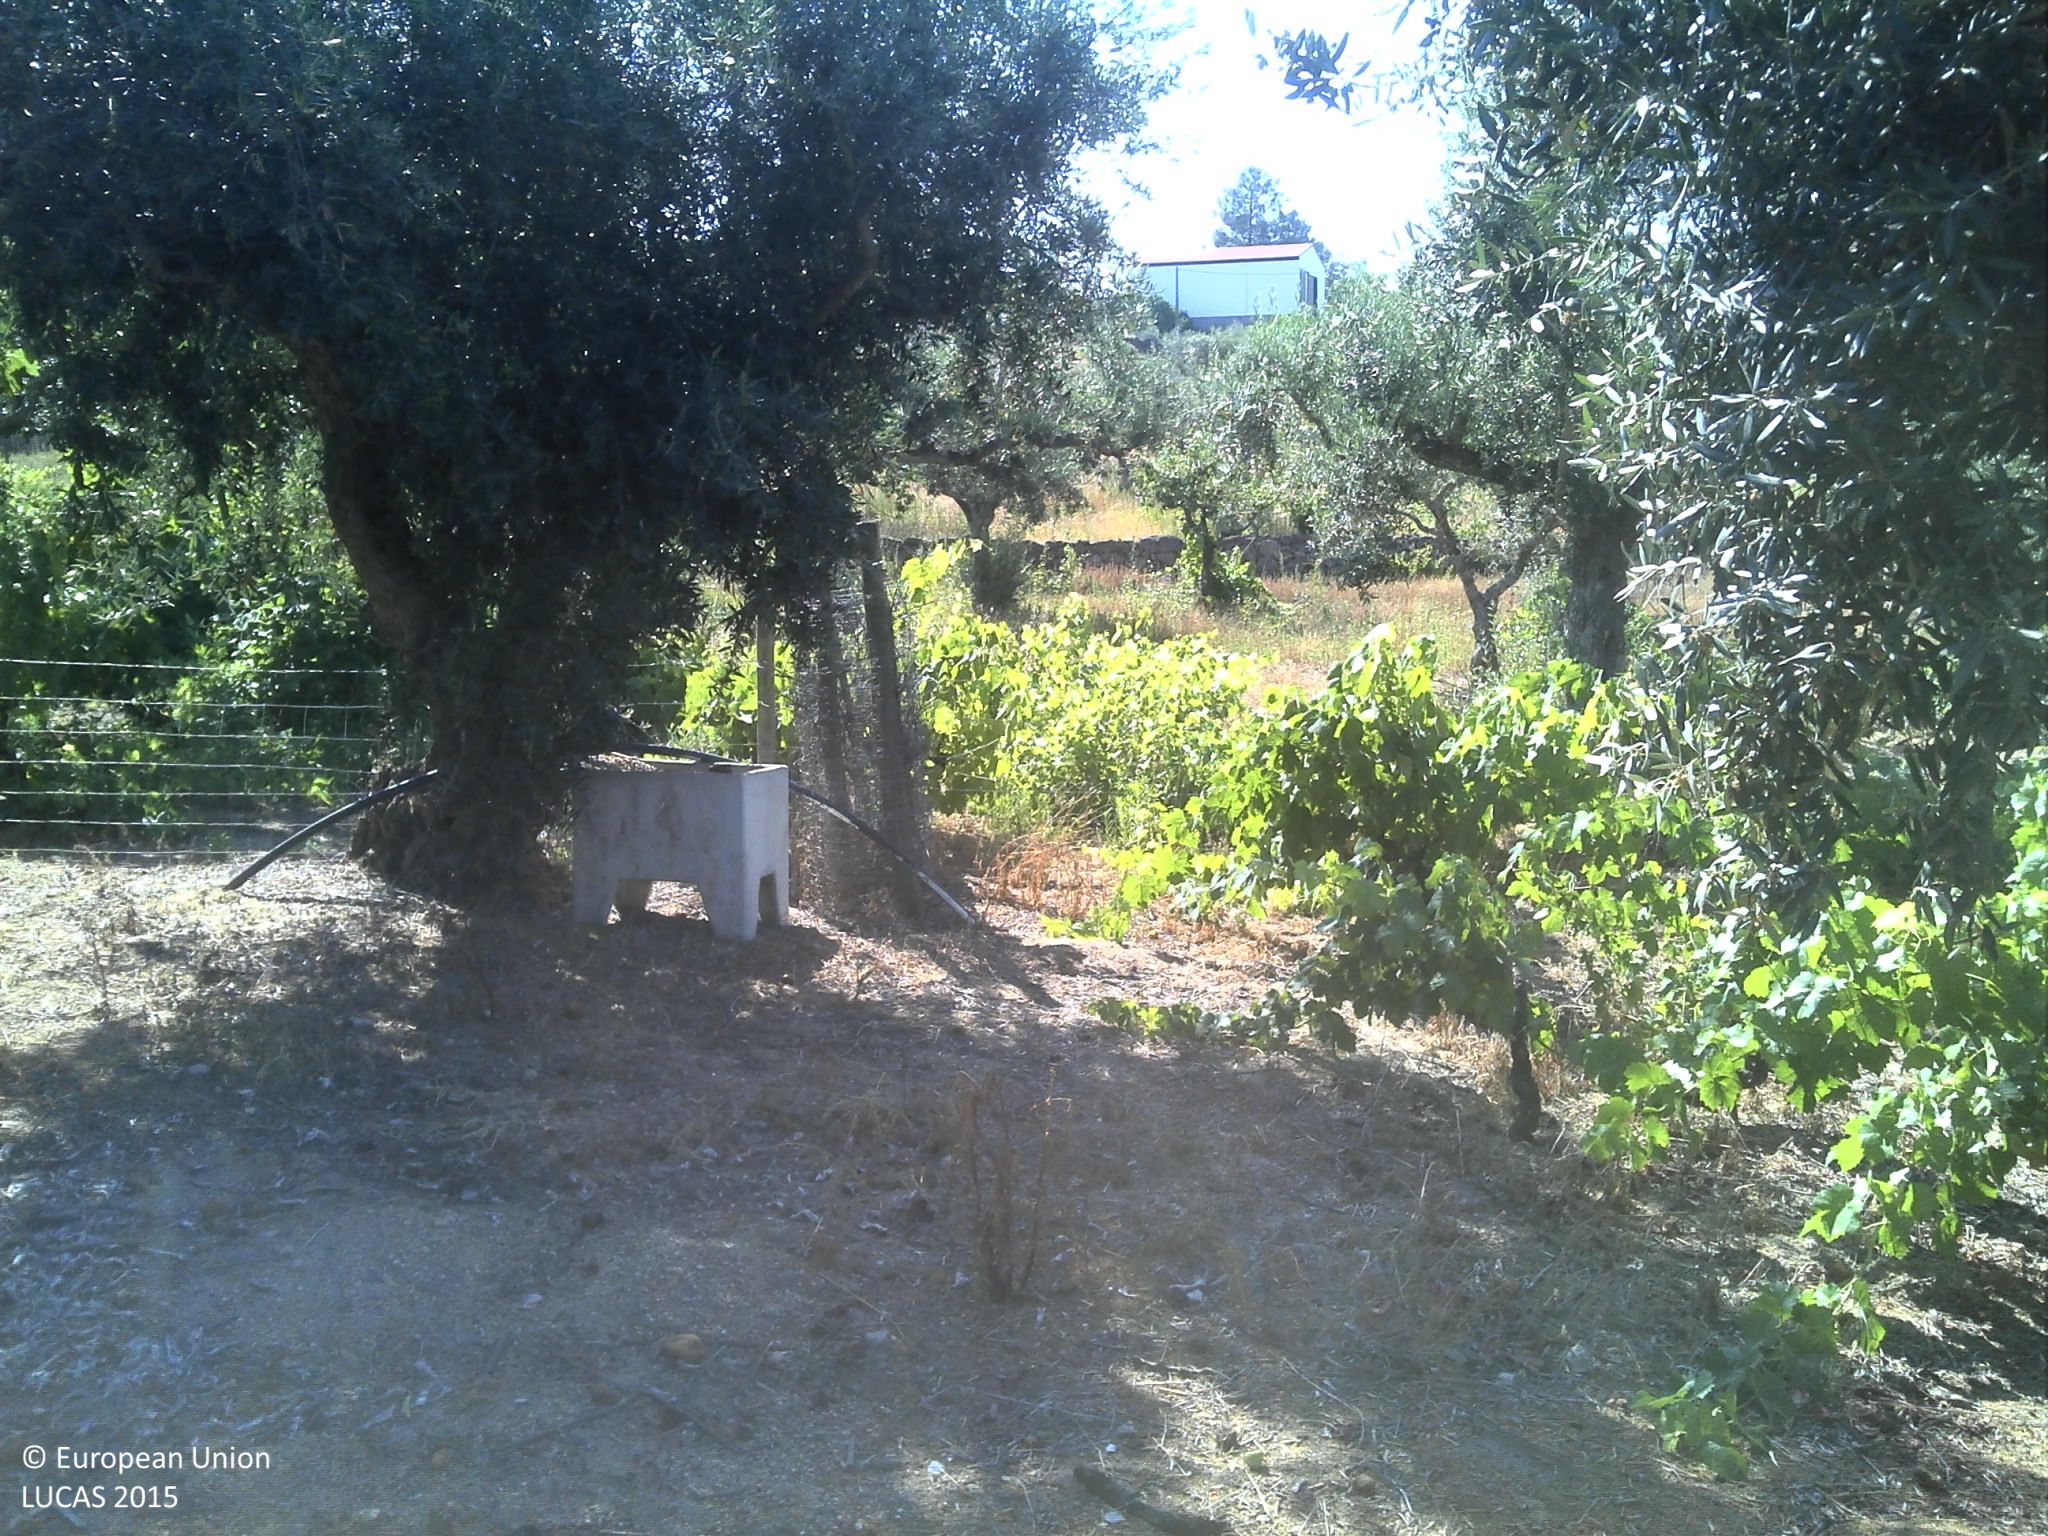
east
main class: Cropland
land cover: Olive groves
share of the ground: 25 - 50 %
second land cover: Vineyards
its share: 10 - 25 %
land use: Agriculture (excluding fallow land and kitchen gardens)
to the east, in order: Olive groves; Vineyards; Fences; Olive groves; Dry stone walls; Olive groves; Dry stone walls; Fences; Olive groves; Dry stone walls; Olive groves; Electric lines; Olive groves; Fences; Olive groves; Dry stone walls; Olive groves; Dry stone walls; Olive groves; Dry stone walls; Tracks; Grassland without tree/shrub cover; Dry stone walls; Single bushes/trees; Grassland without tree/shrub cover; Dry stone walls; Vineyards; Olive groves; Dry stone walls; Olive groves
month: June
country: PT
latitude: 39.8527
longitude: -7.5515
